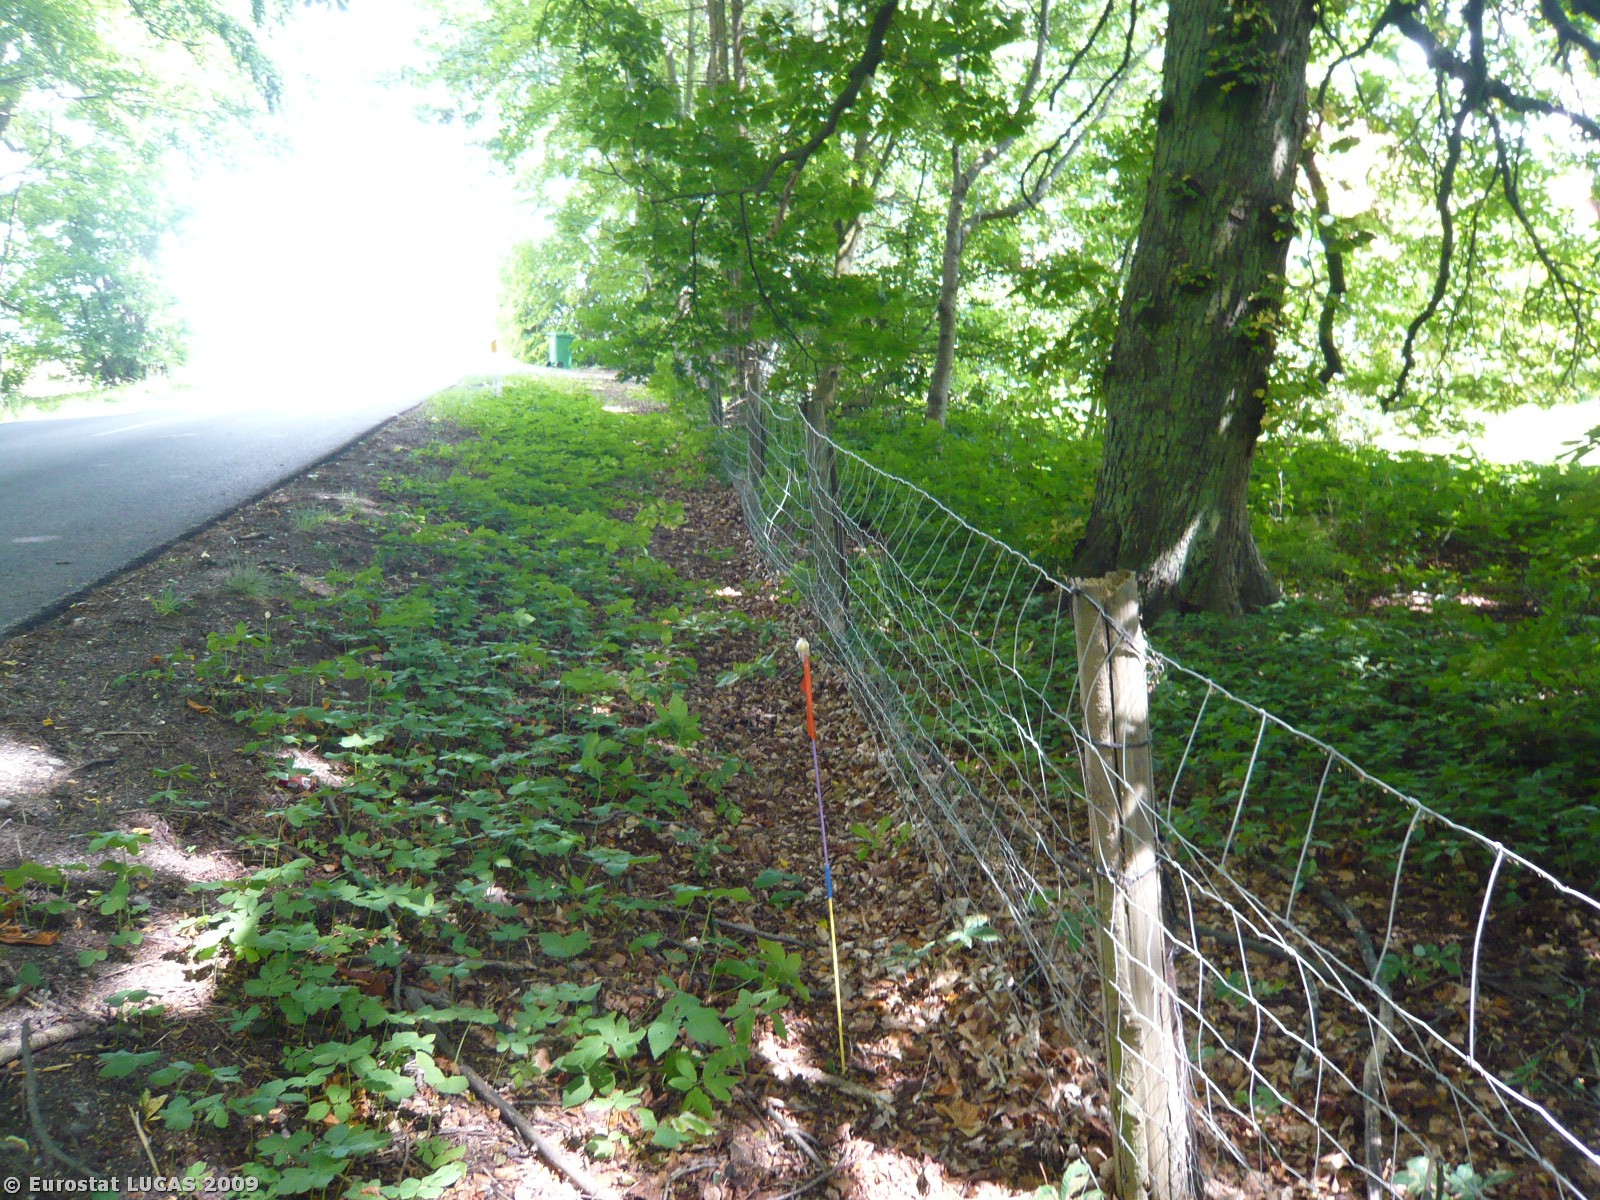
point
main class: Woodland
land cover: Broadleaved woodland
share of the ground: > 75 %
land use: Residential
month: July
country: DK
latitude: 55.4359
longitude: 11.9424
